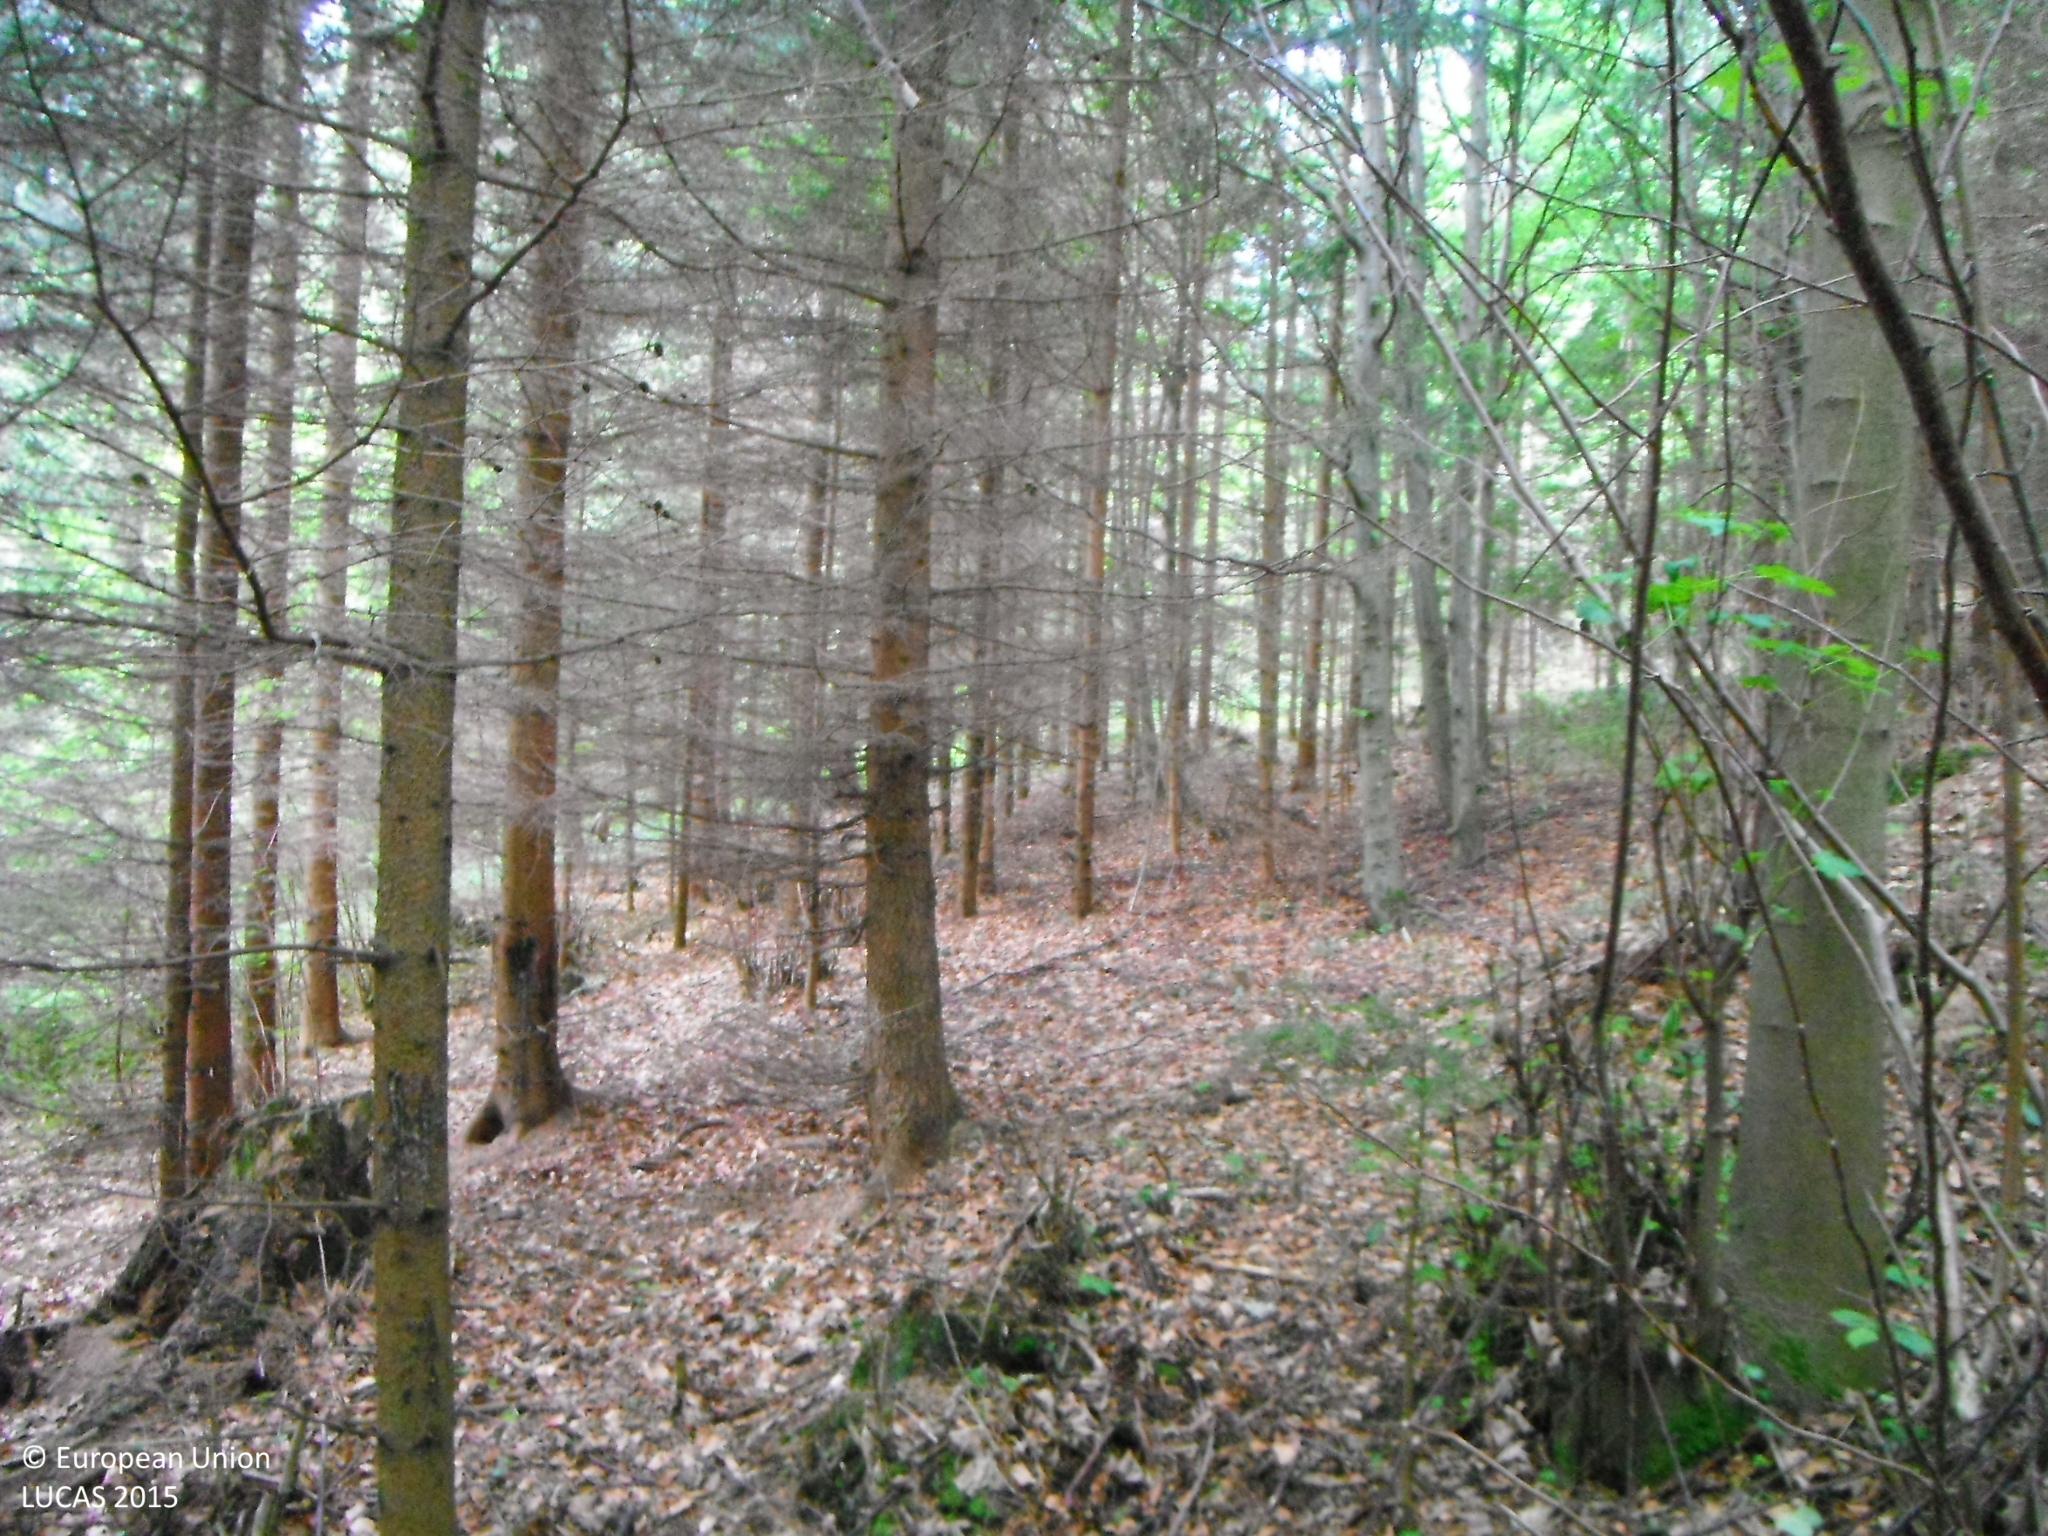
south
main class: Woodland
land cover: Spruce dominated mixed woodland
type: alpine coniferous forest
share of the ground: > 75 %
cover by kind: coniferous forest trees 70 %, broadleaved forest trees 30 %
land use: Forestry
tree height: > 5 m
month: June
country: SK
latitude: 49.1534
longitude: 19.2792
